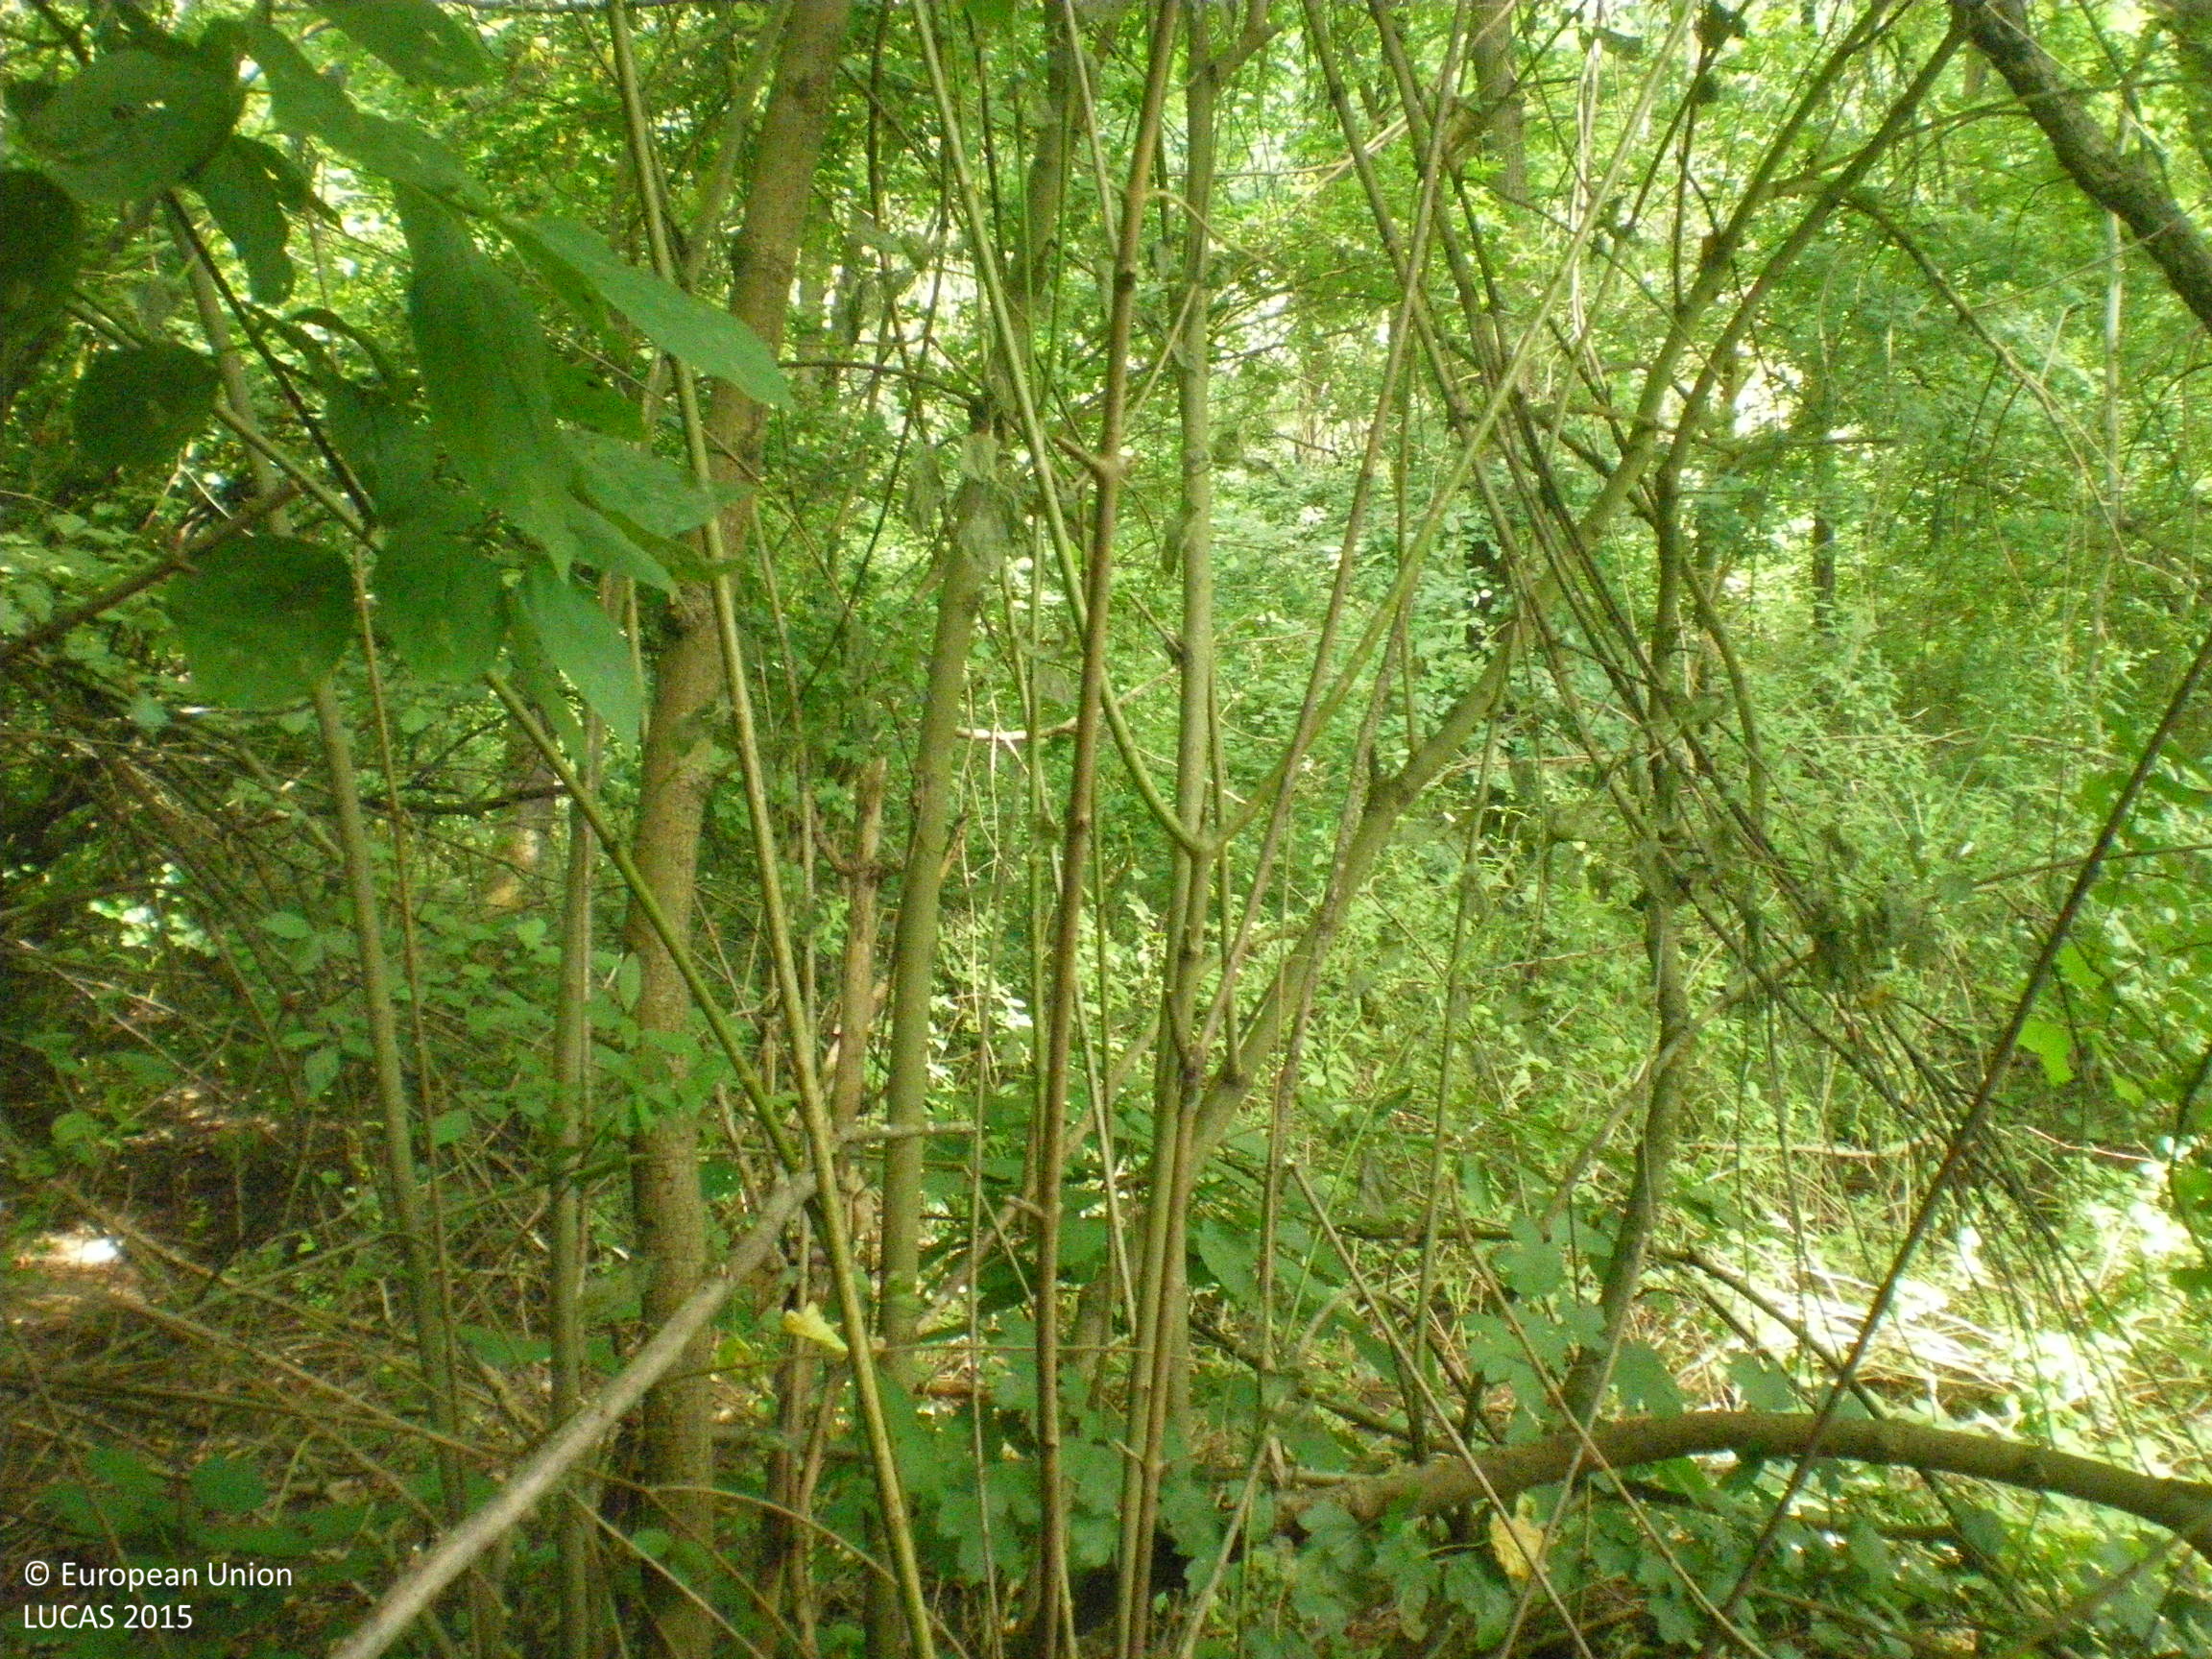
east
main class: Woodland
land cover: Broadleaved woodland
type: mesophytic deciduous forest
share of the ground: > 75 %
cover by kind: broadleaved forest trees 90 %, shrubs 10 %
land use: Forestry
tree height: > 5 m
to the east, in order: Broadleaved woodland; Tracks; Broadleaved woodland; Grassland without tree/shrub cover; Tracks; Grass margins; Tracks; Broadleaved woodland
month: June
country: BG
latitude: 42.1453
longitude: 25.1727
